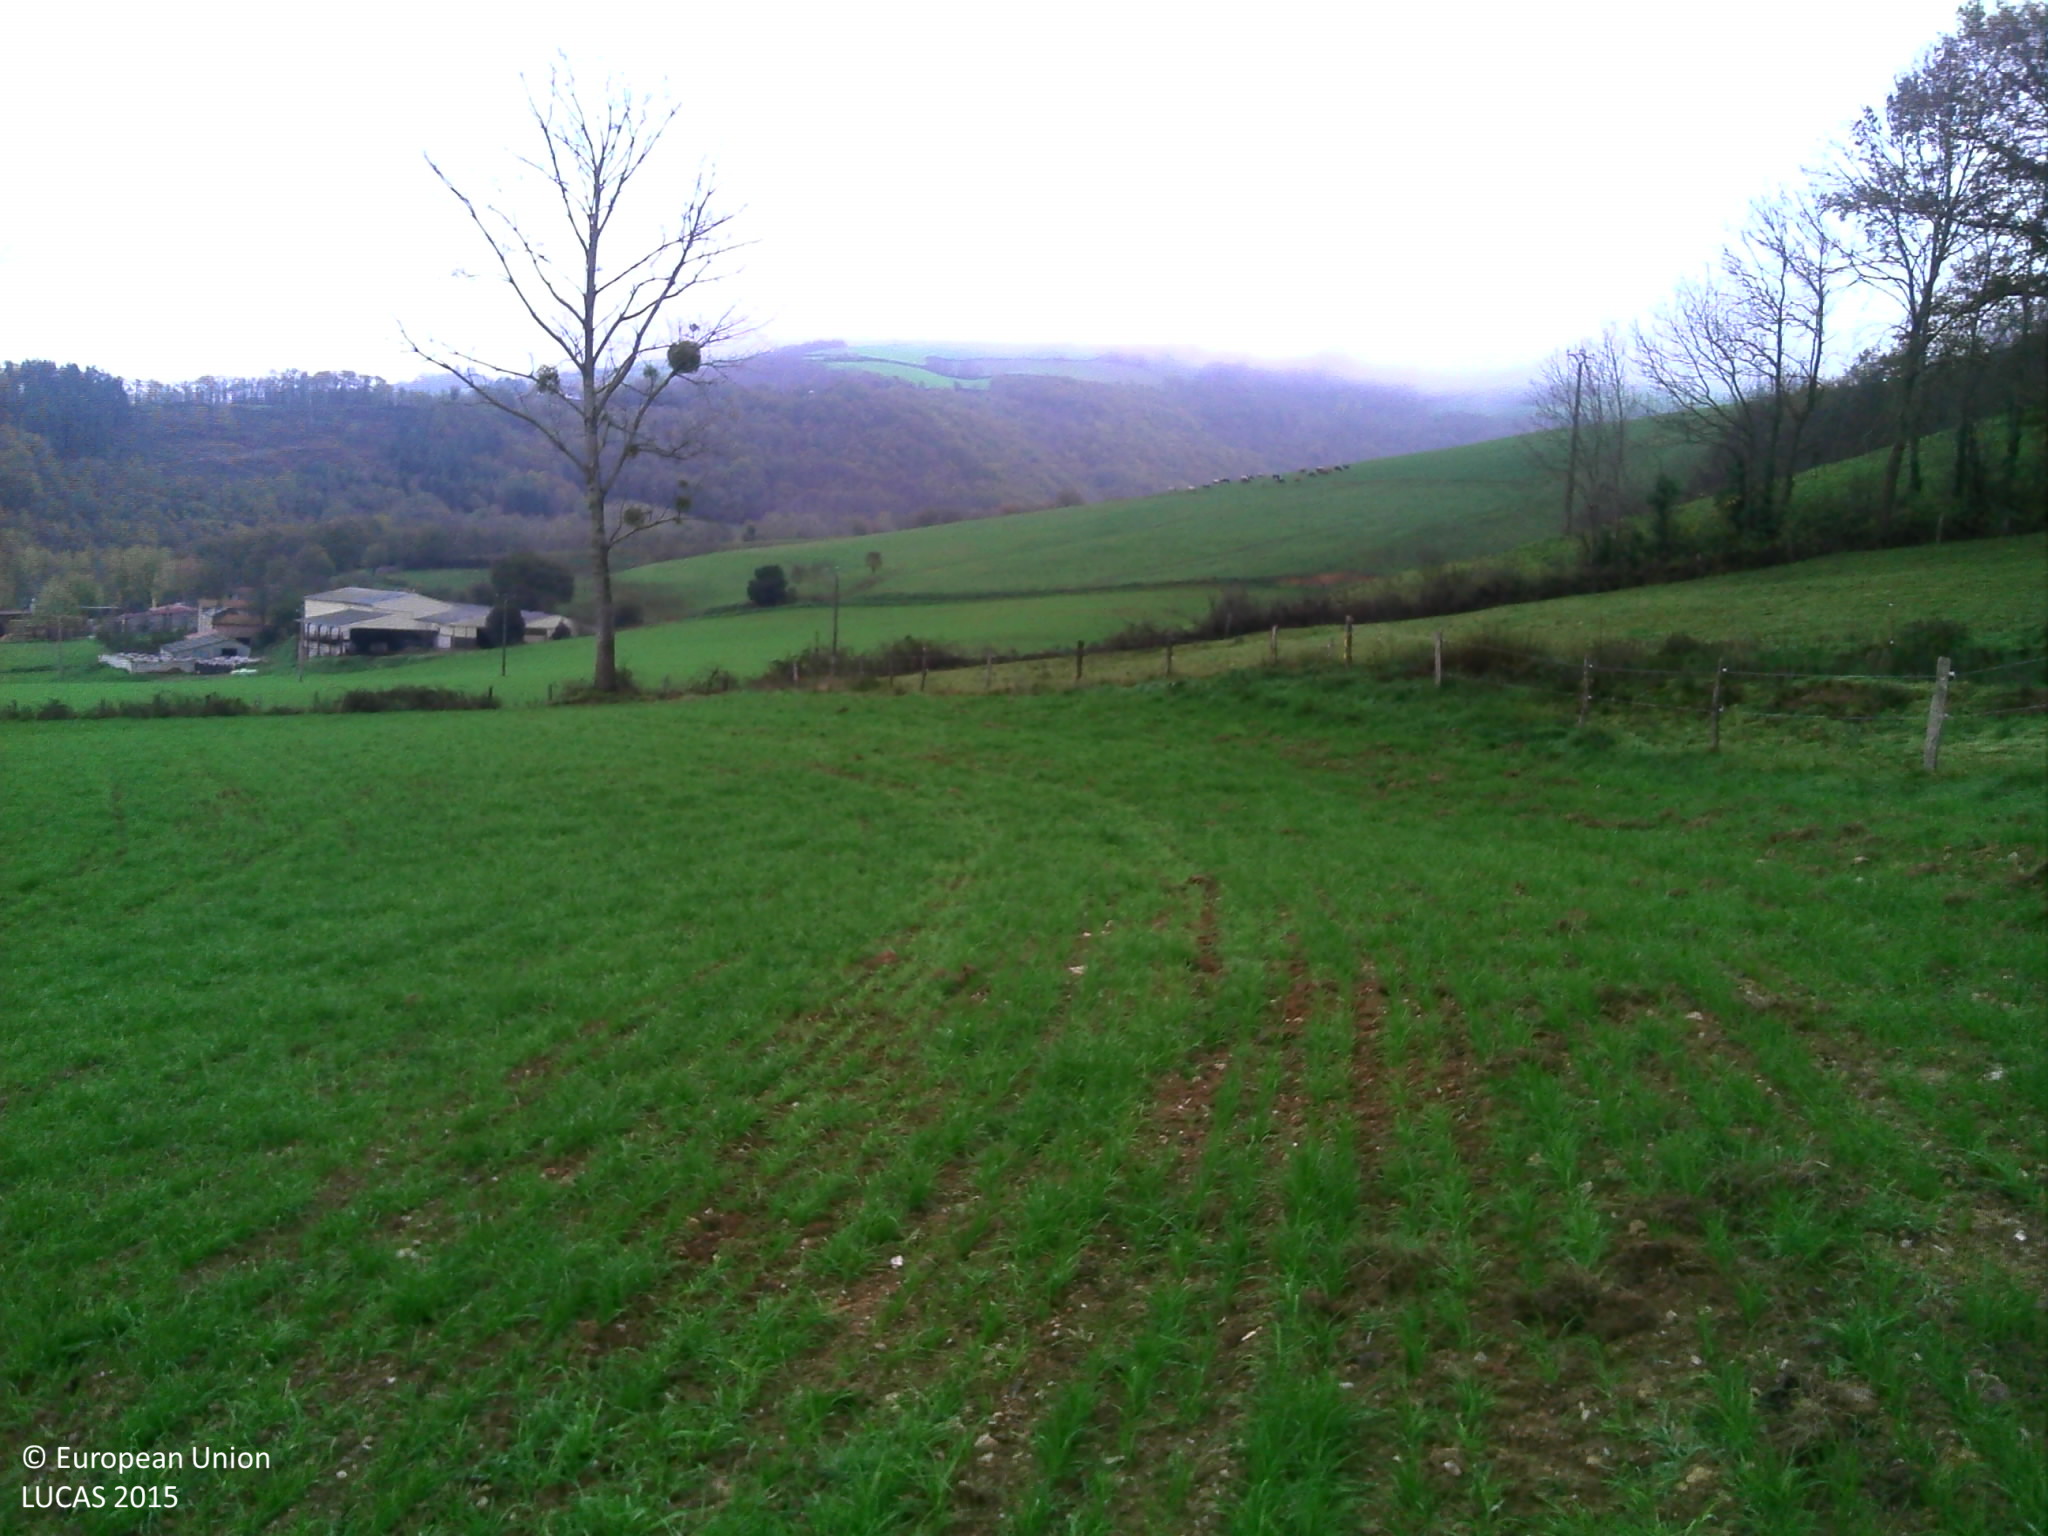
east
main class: Cropland
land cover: Temporary grasslands
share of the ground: > 75 %
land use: Agriculture (excluding fallow land and kitchen gardens)
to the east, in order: Temporary grasslands; Fences; Single bushes/trees; Ditches and canals; Temporary grasslands; Electric lines; Temporary grasslands
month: November
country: FR
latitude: 43.9192
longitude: 2.5453
